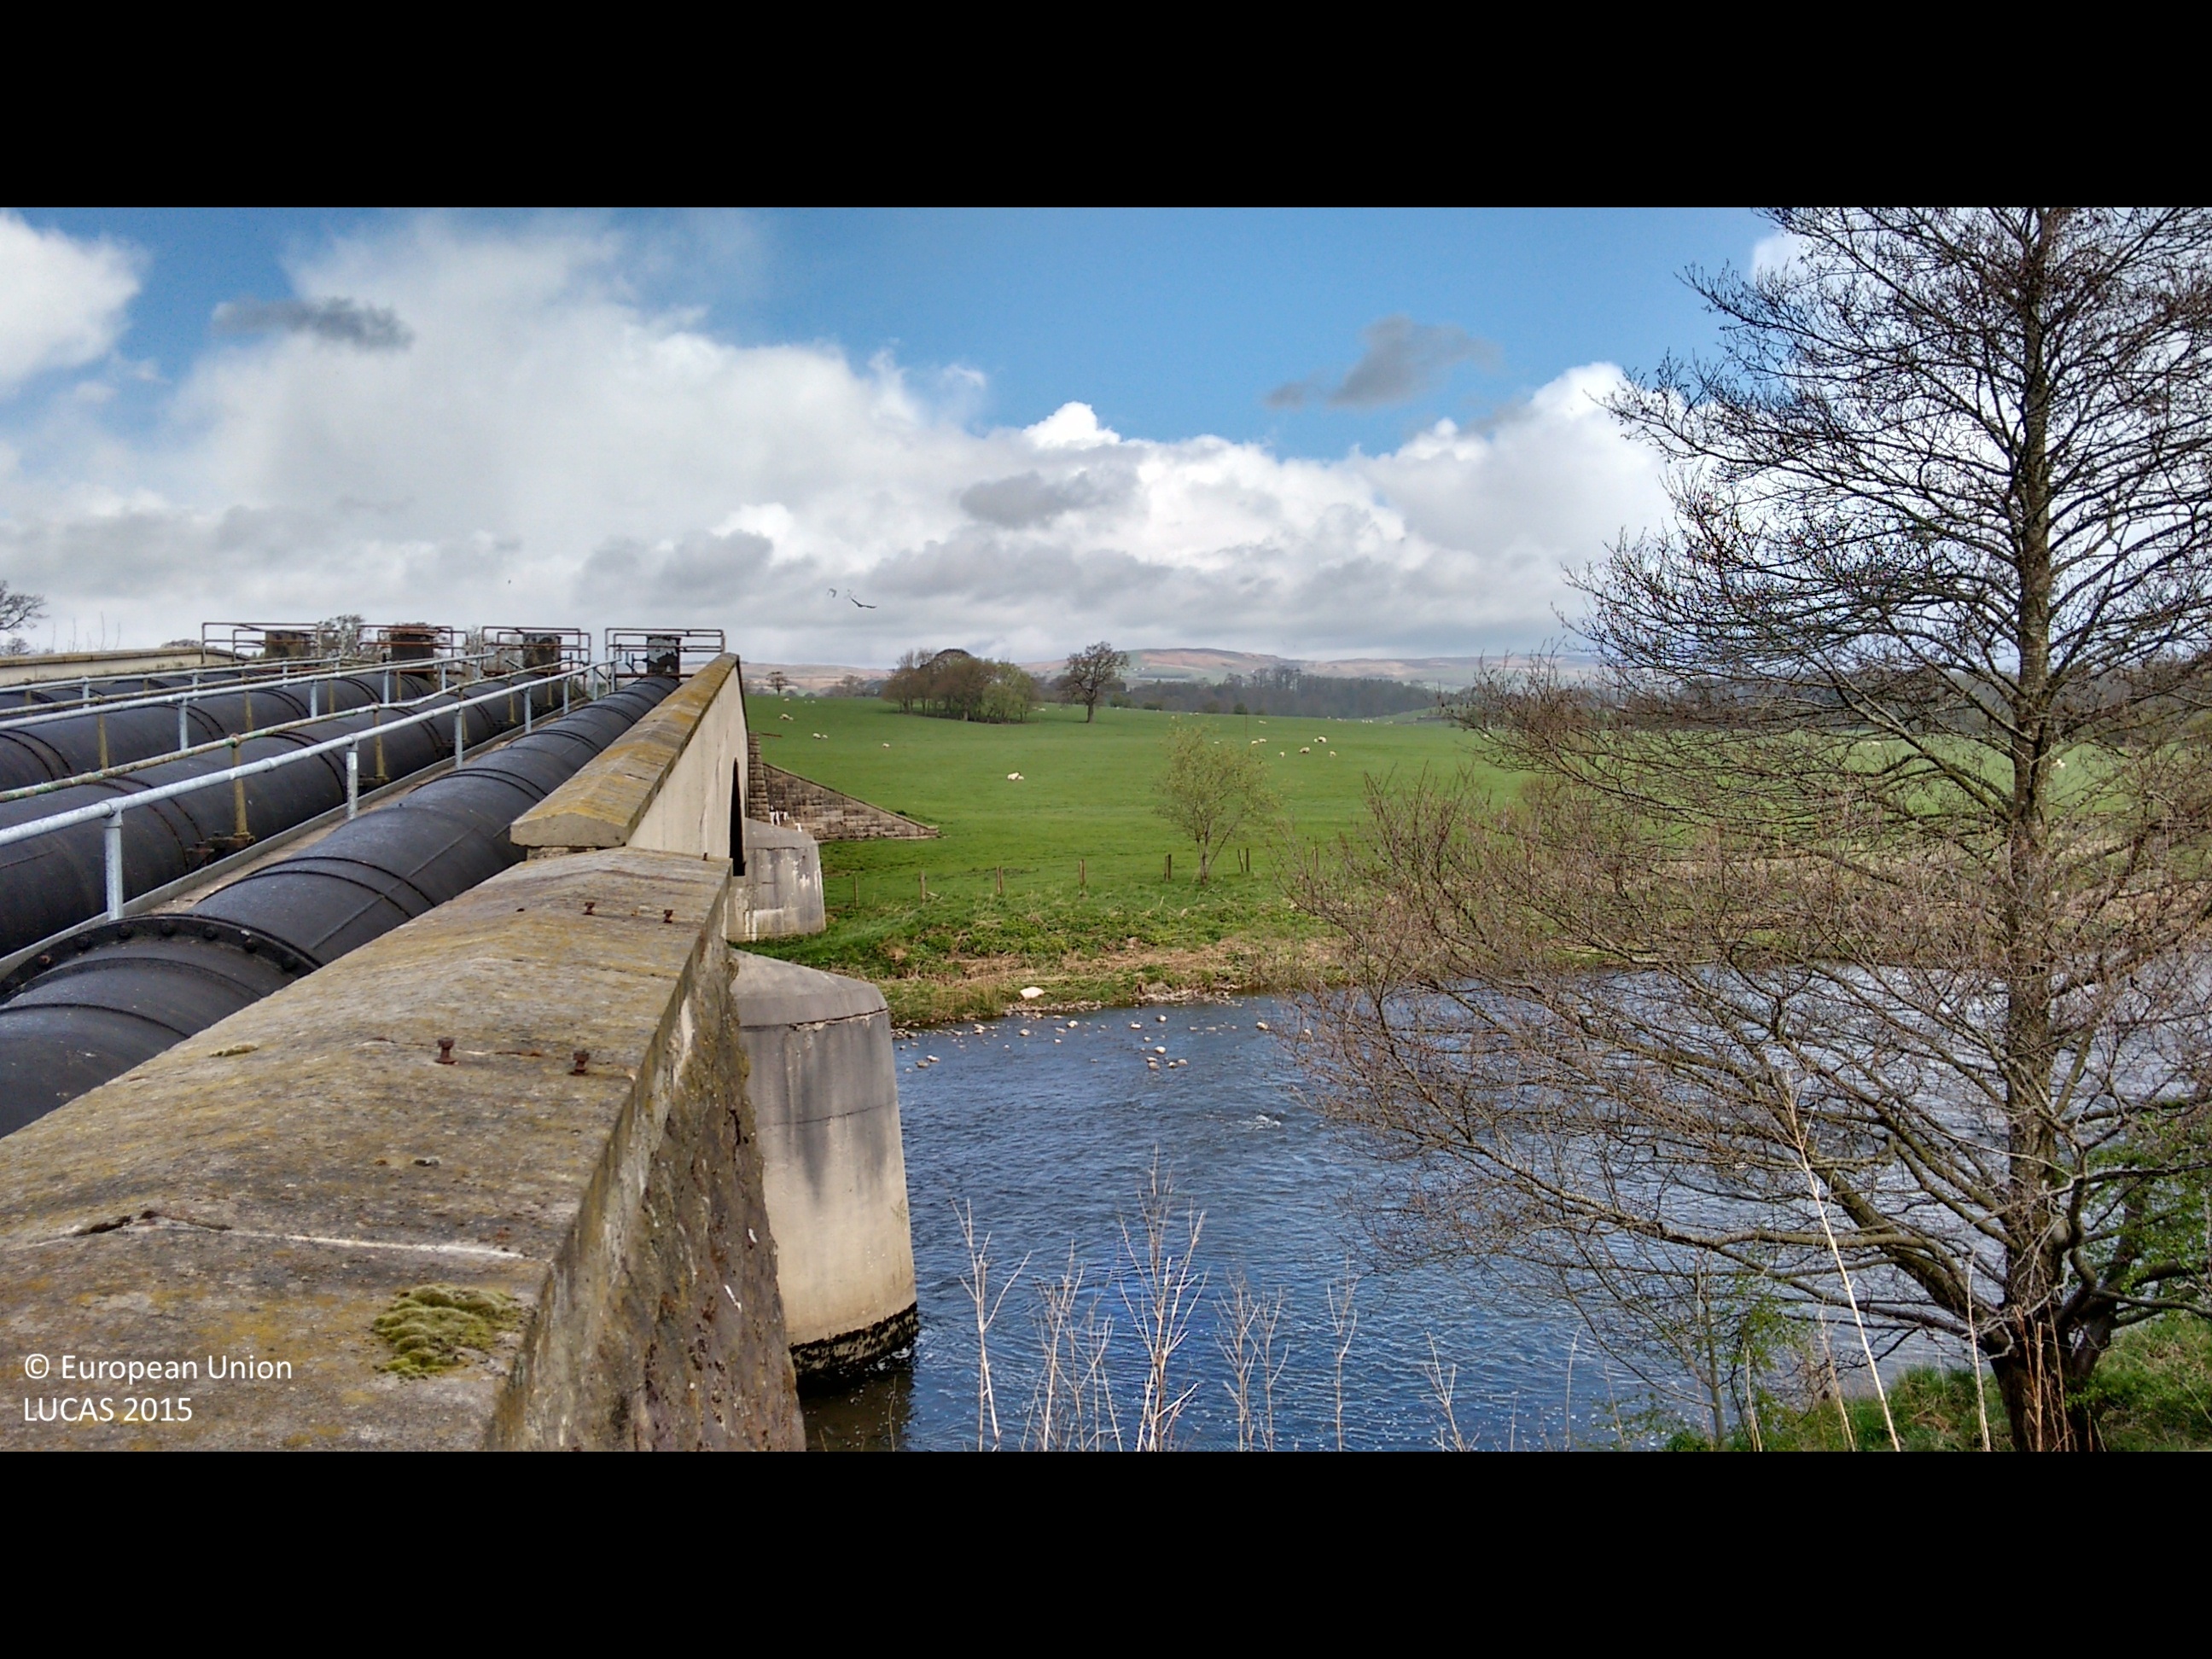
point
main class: Grassland
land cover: Grassland without tree/shrub cover
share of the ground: > 75 %
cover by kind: herbaceous plants 100 %
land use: Agriculture (excluding fallow land and kitchen gardens)
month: April
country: GB
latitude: 53.8513
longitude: -2.4225
